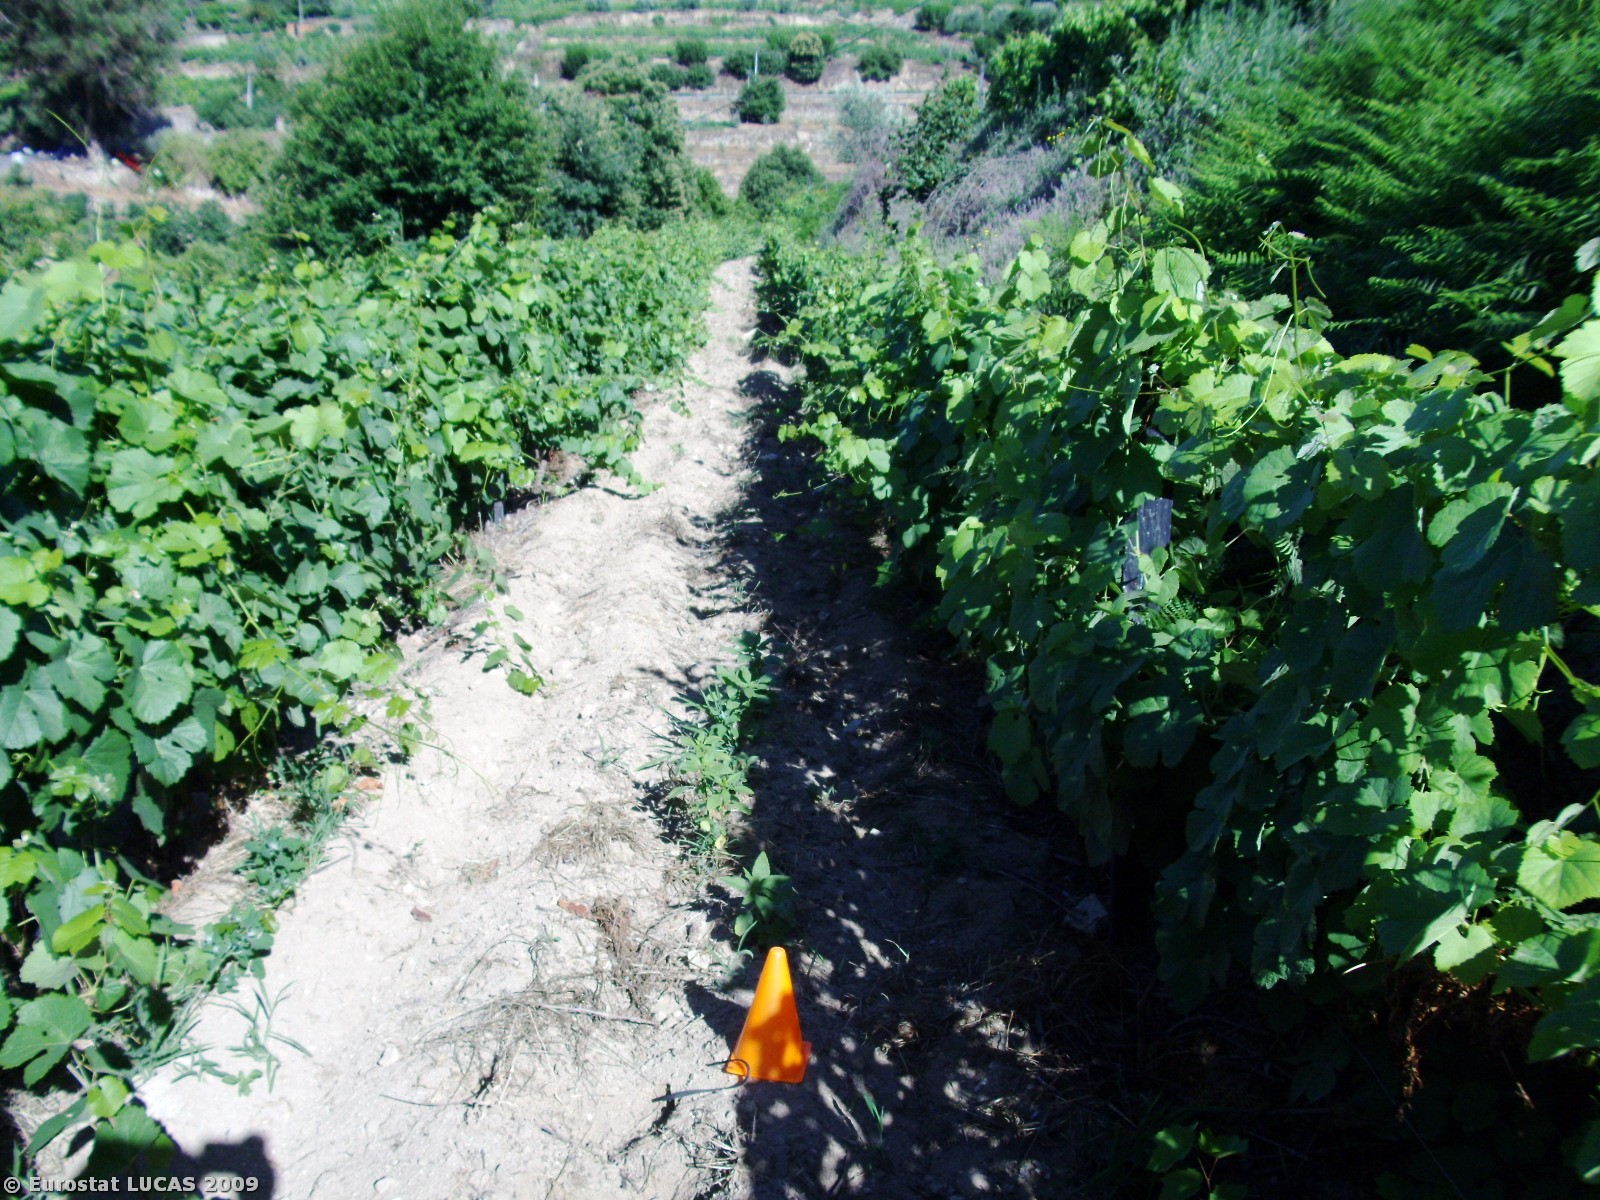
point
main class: Cropland
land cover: Vineyards
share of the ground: 25 - 50 %
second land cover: Bare land
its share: > 75 %
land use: Agriculture (excluding fallow land and kitchen gardens)
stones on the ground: < 10 %
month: July
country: PT
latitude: 41.0842
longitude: -7.7811
